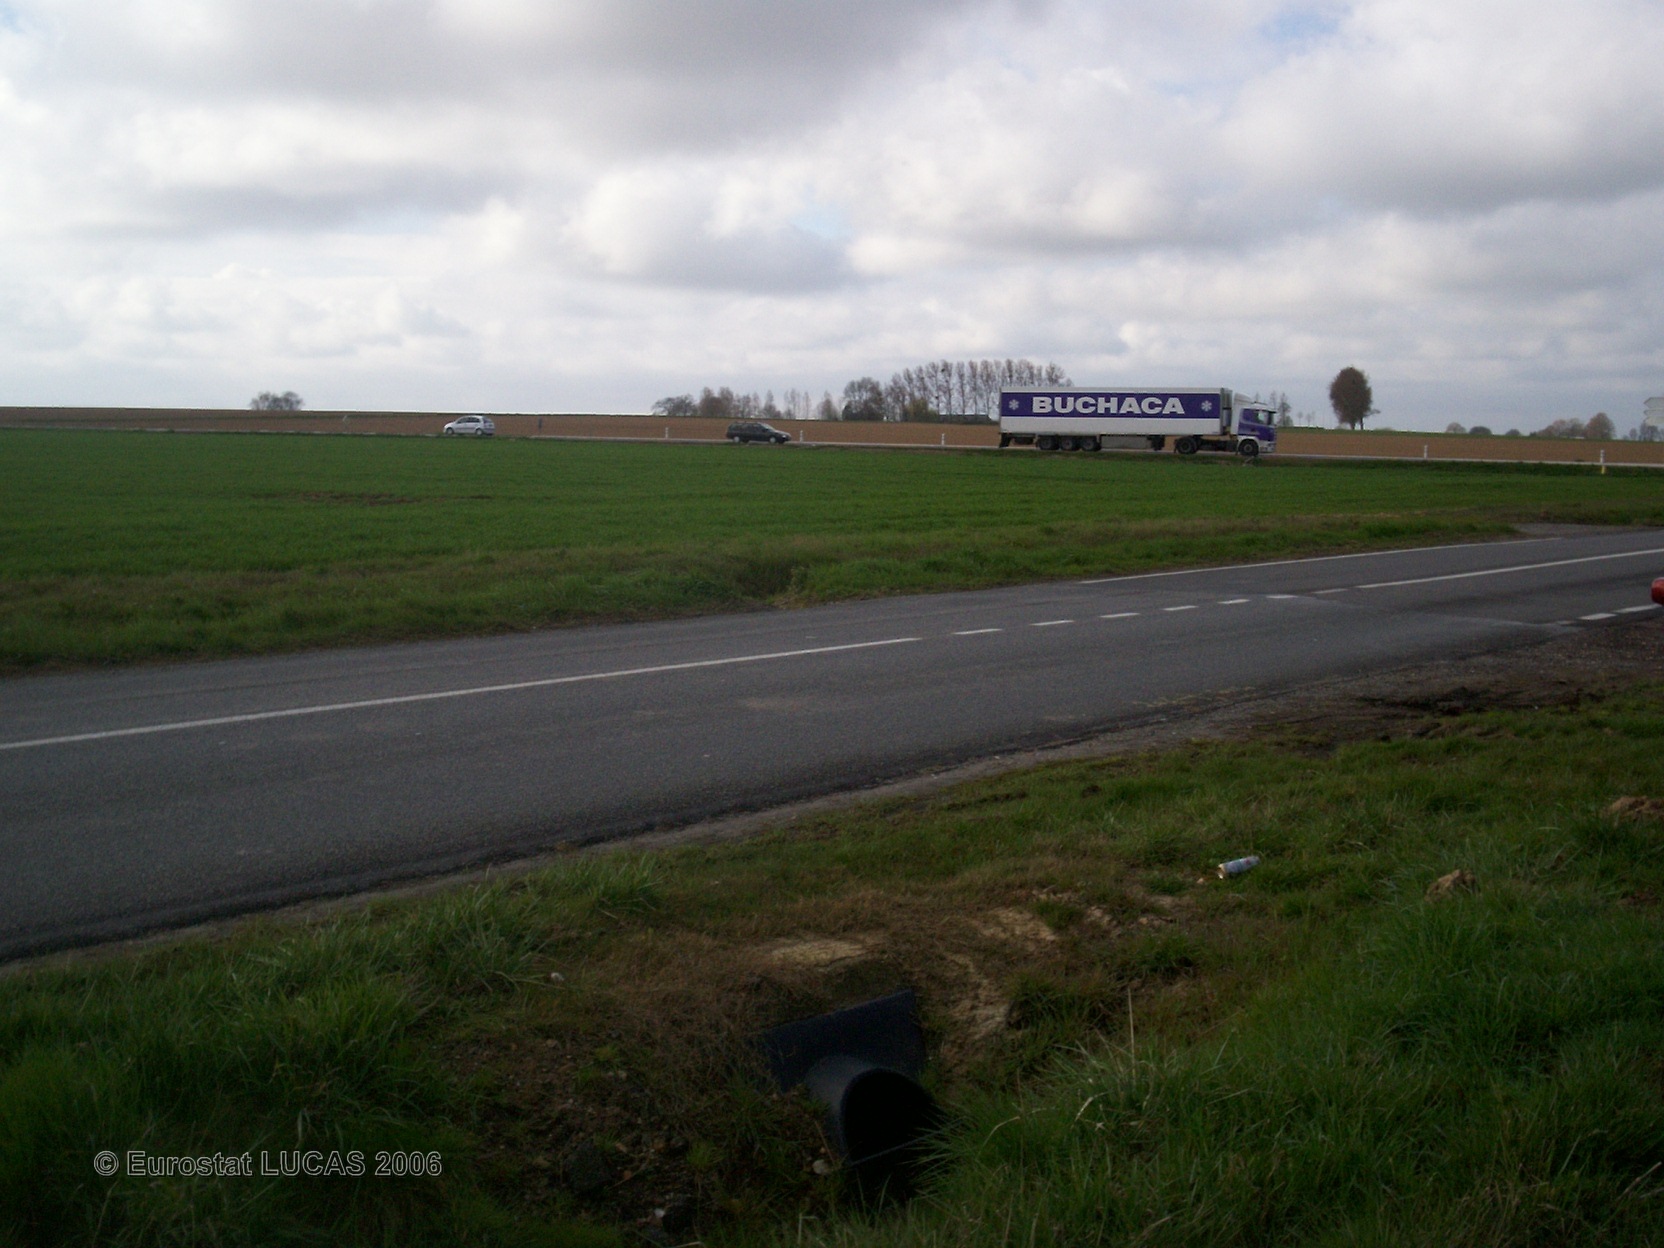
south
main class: Grassland
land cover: Grassland without tree/shrub cover
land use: Agriculture (excluding fallow land and kitchen gardens)
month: April
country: FR
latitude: 49.5679
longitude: 0.9201
